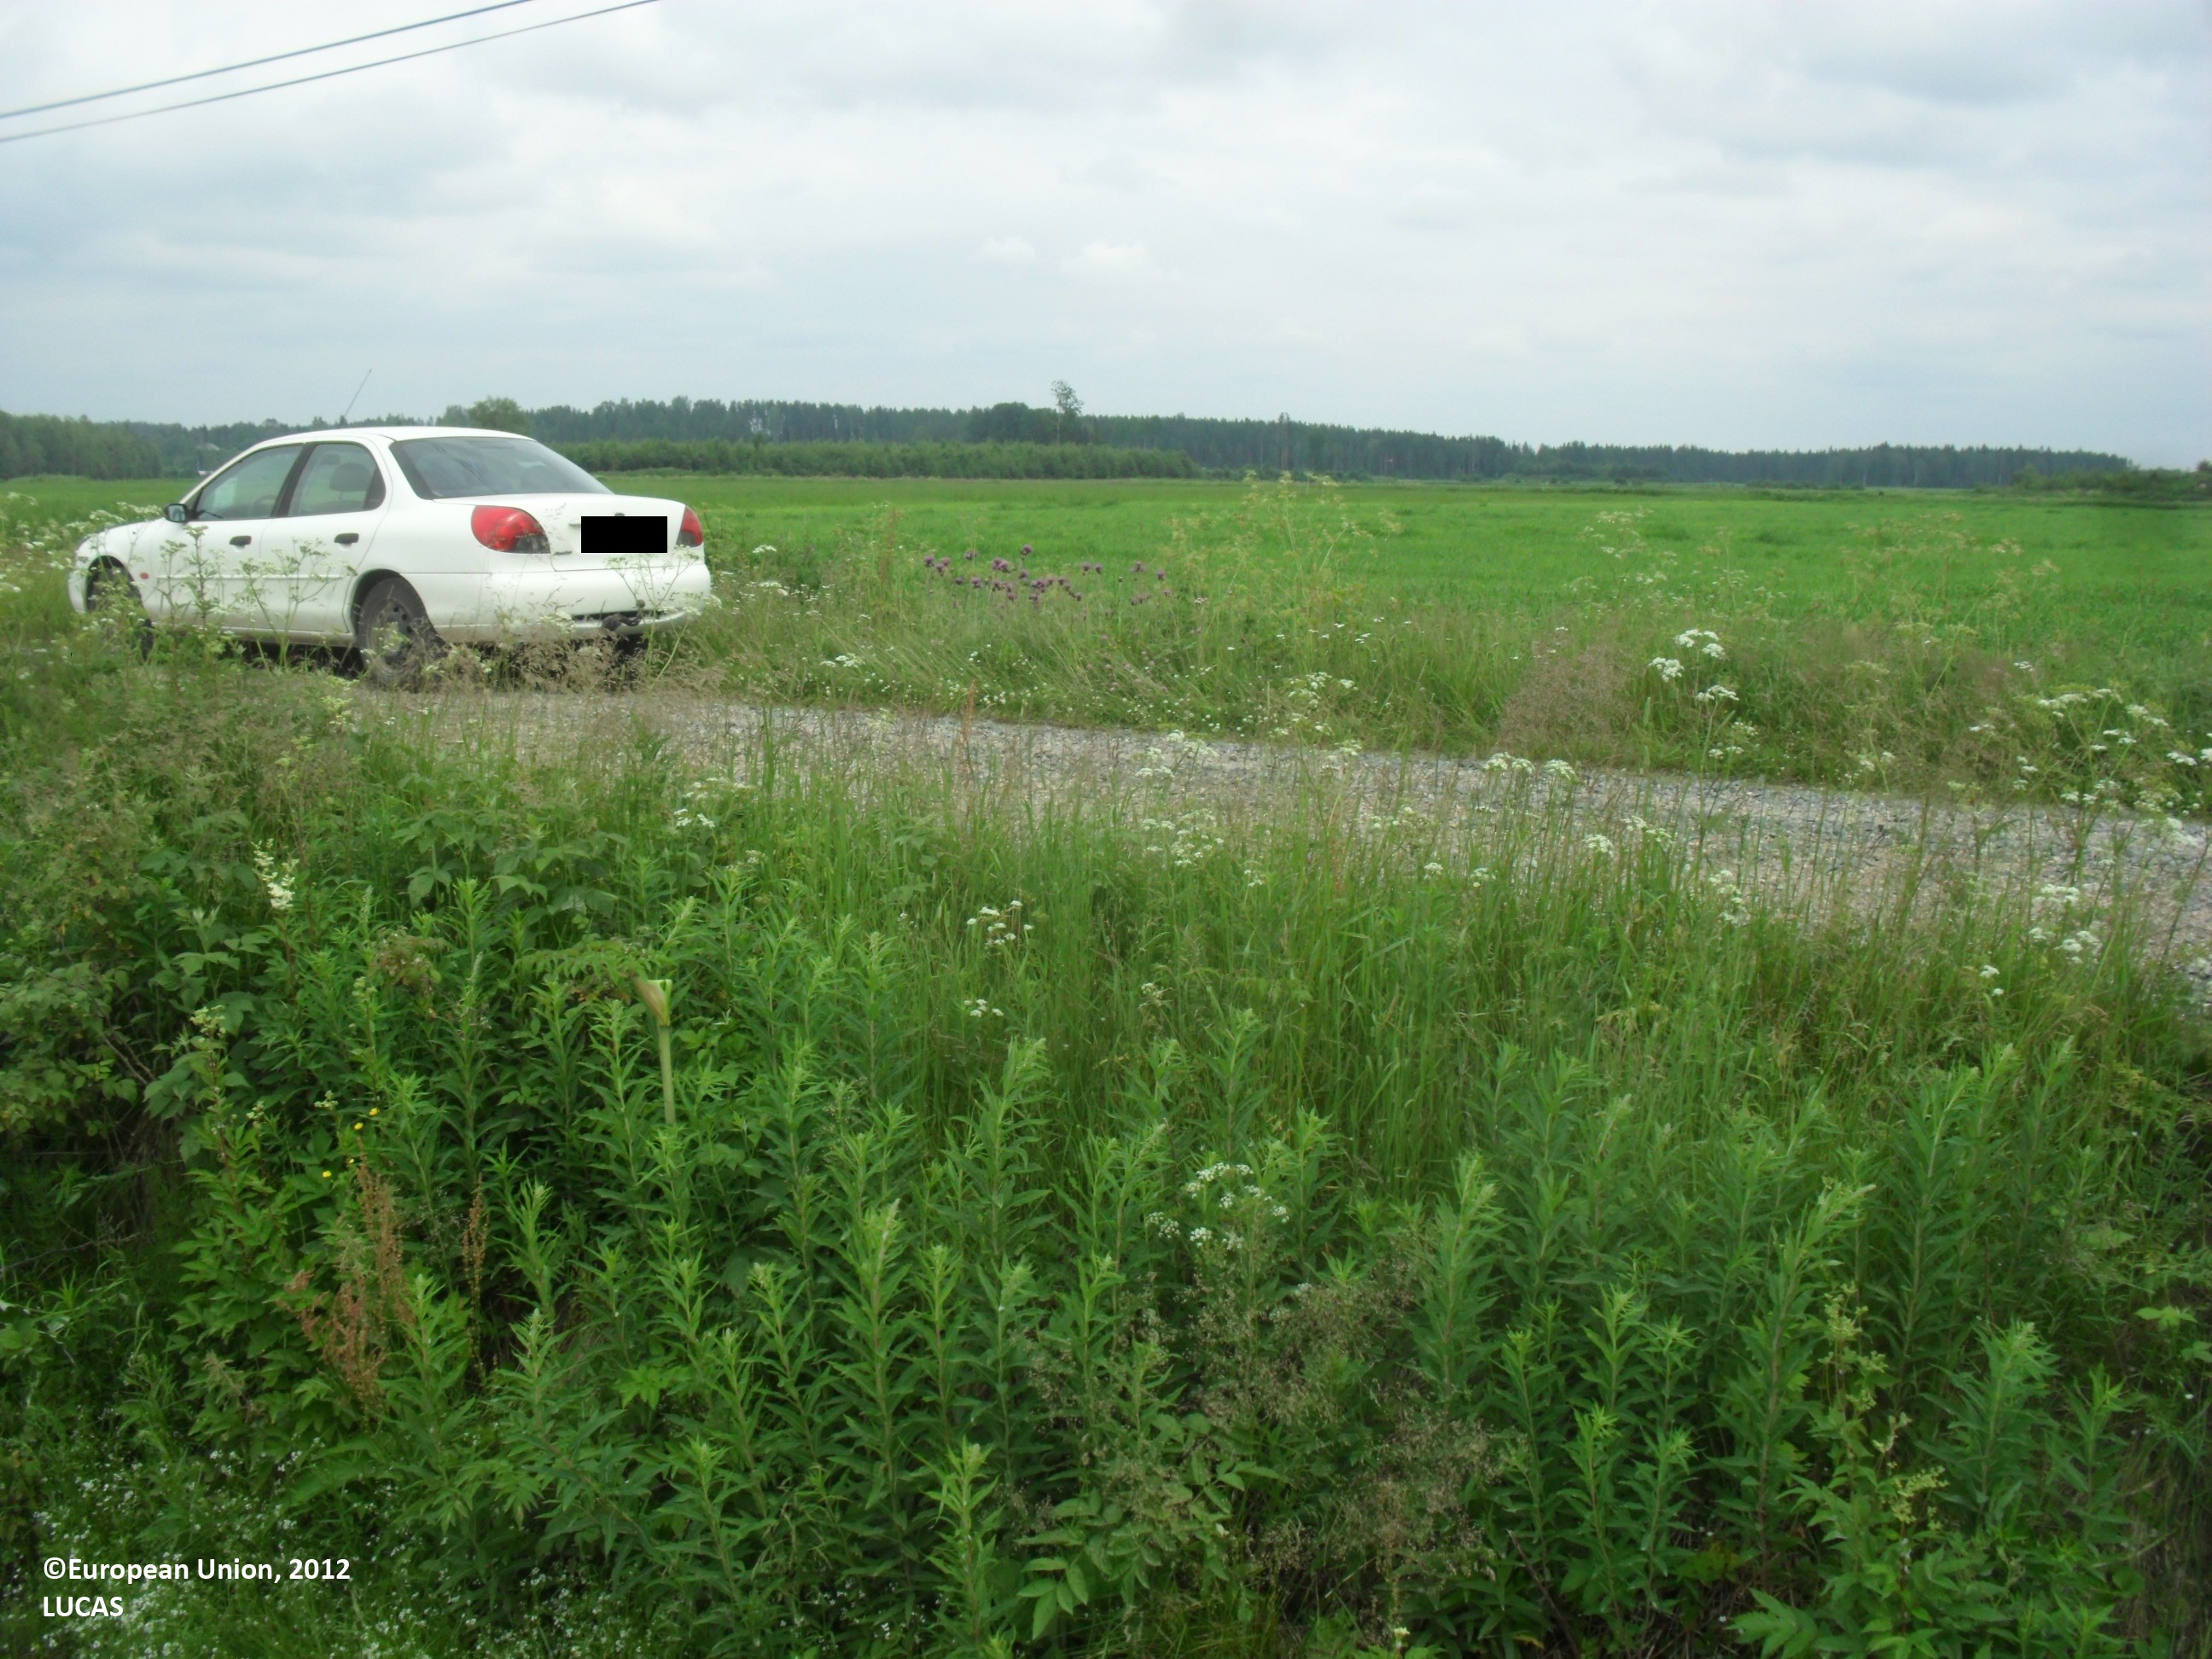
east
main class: Cropland
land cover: Barley
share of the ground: > 75 %
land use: Agriculture (excluding fallow land and kitchen gardens)
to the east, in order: Barley; Grass margins; Ditches and canals; Grass margins; Paved roads, cycling and walking lanes; Grass margins; Ditches and canals; Grass margins; Barley; Temporary grasslands; Ditches and canals; Temporary grasslands
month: July
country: FI
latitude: 63.5971
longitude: 23.5053
